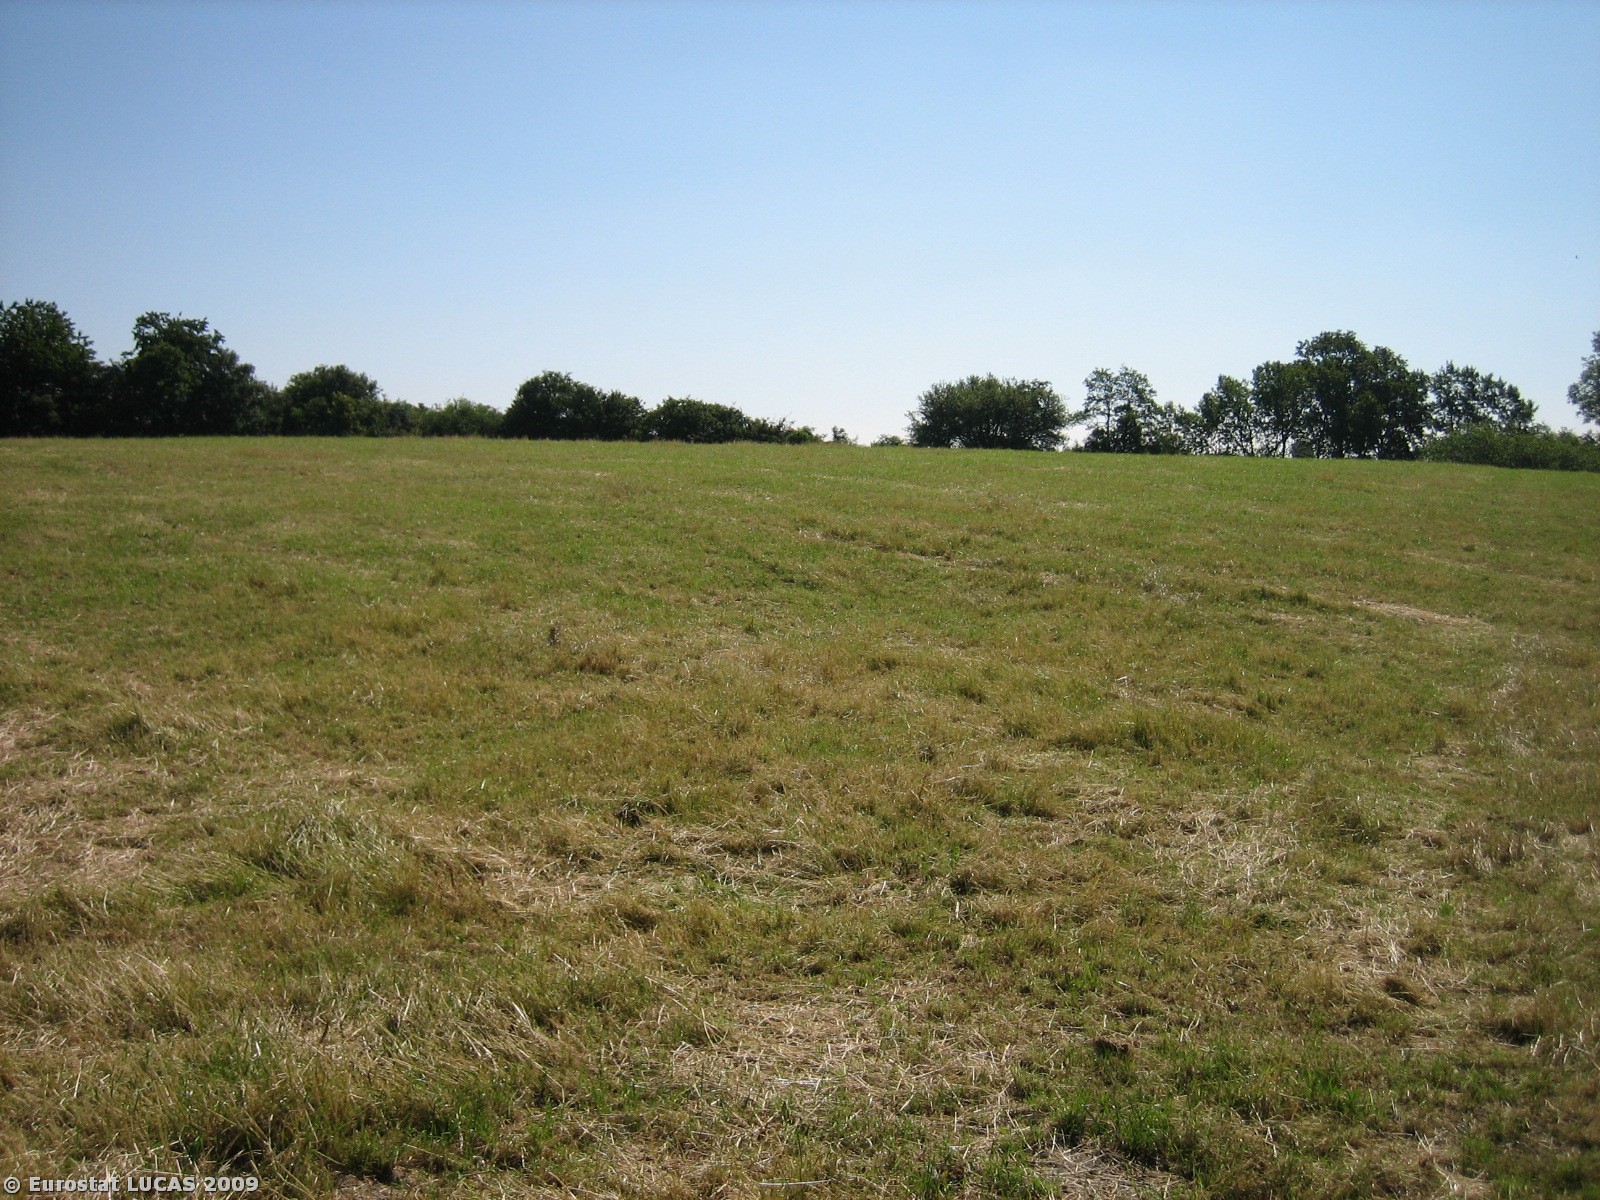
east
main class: Cropland
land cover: Temporary grasslands
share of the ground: > 75 %
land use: Agriculture (excluding fallow land and kitchen gardens)
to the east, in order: Temporary grasslands; Shrubland with sparse tree cover; Grassland without tree/shrub cover
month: June
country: DK
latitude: 55.3949
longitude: 9.2902
